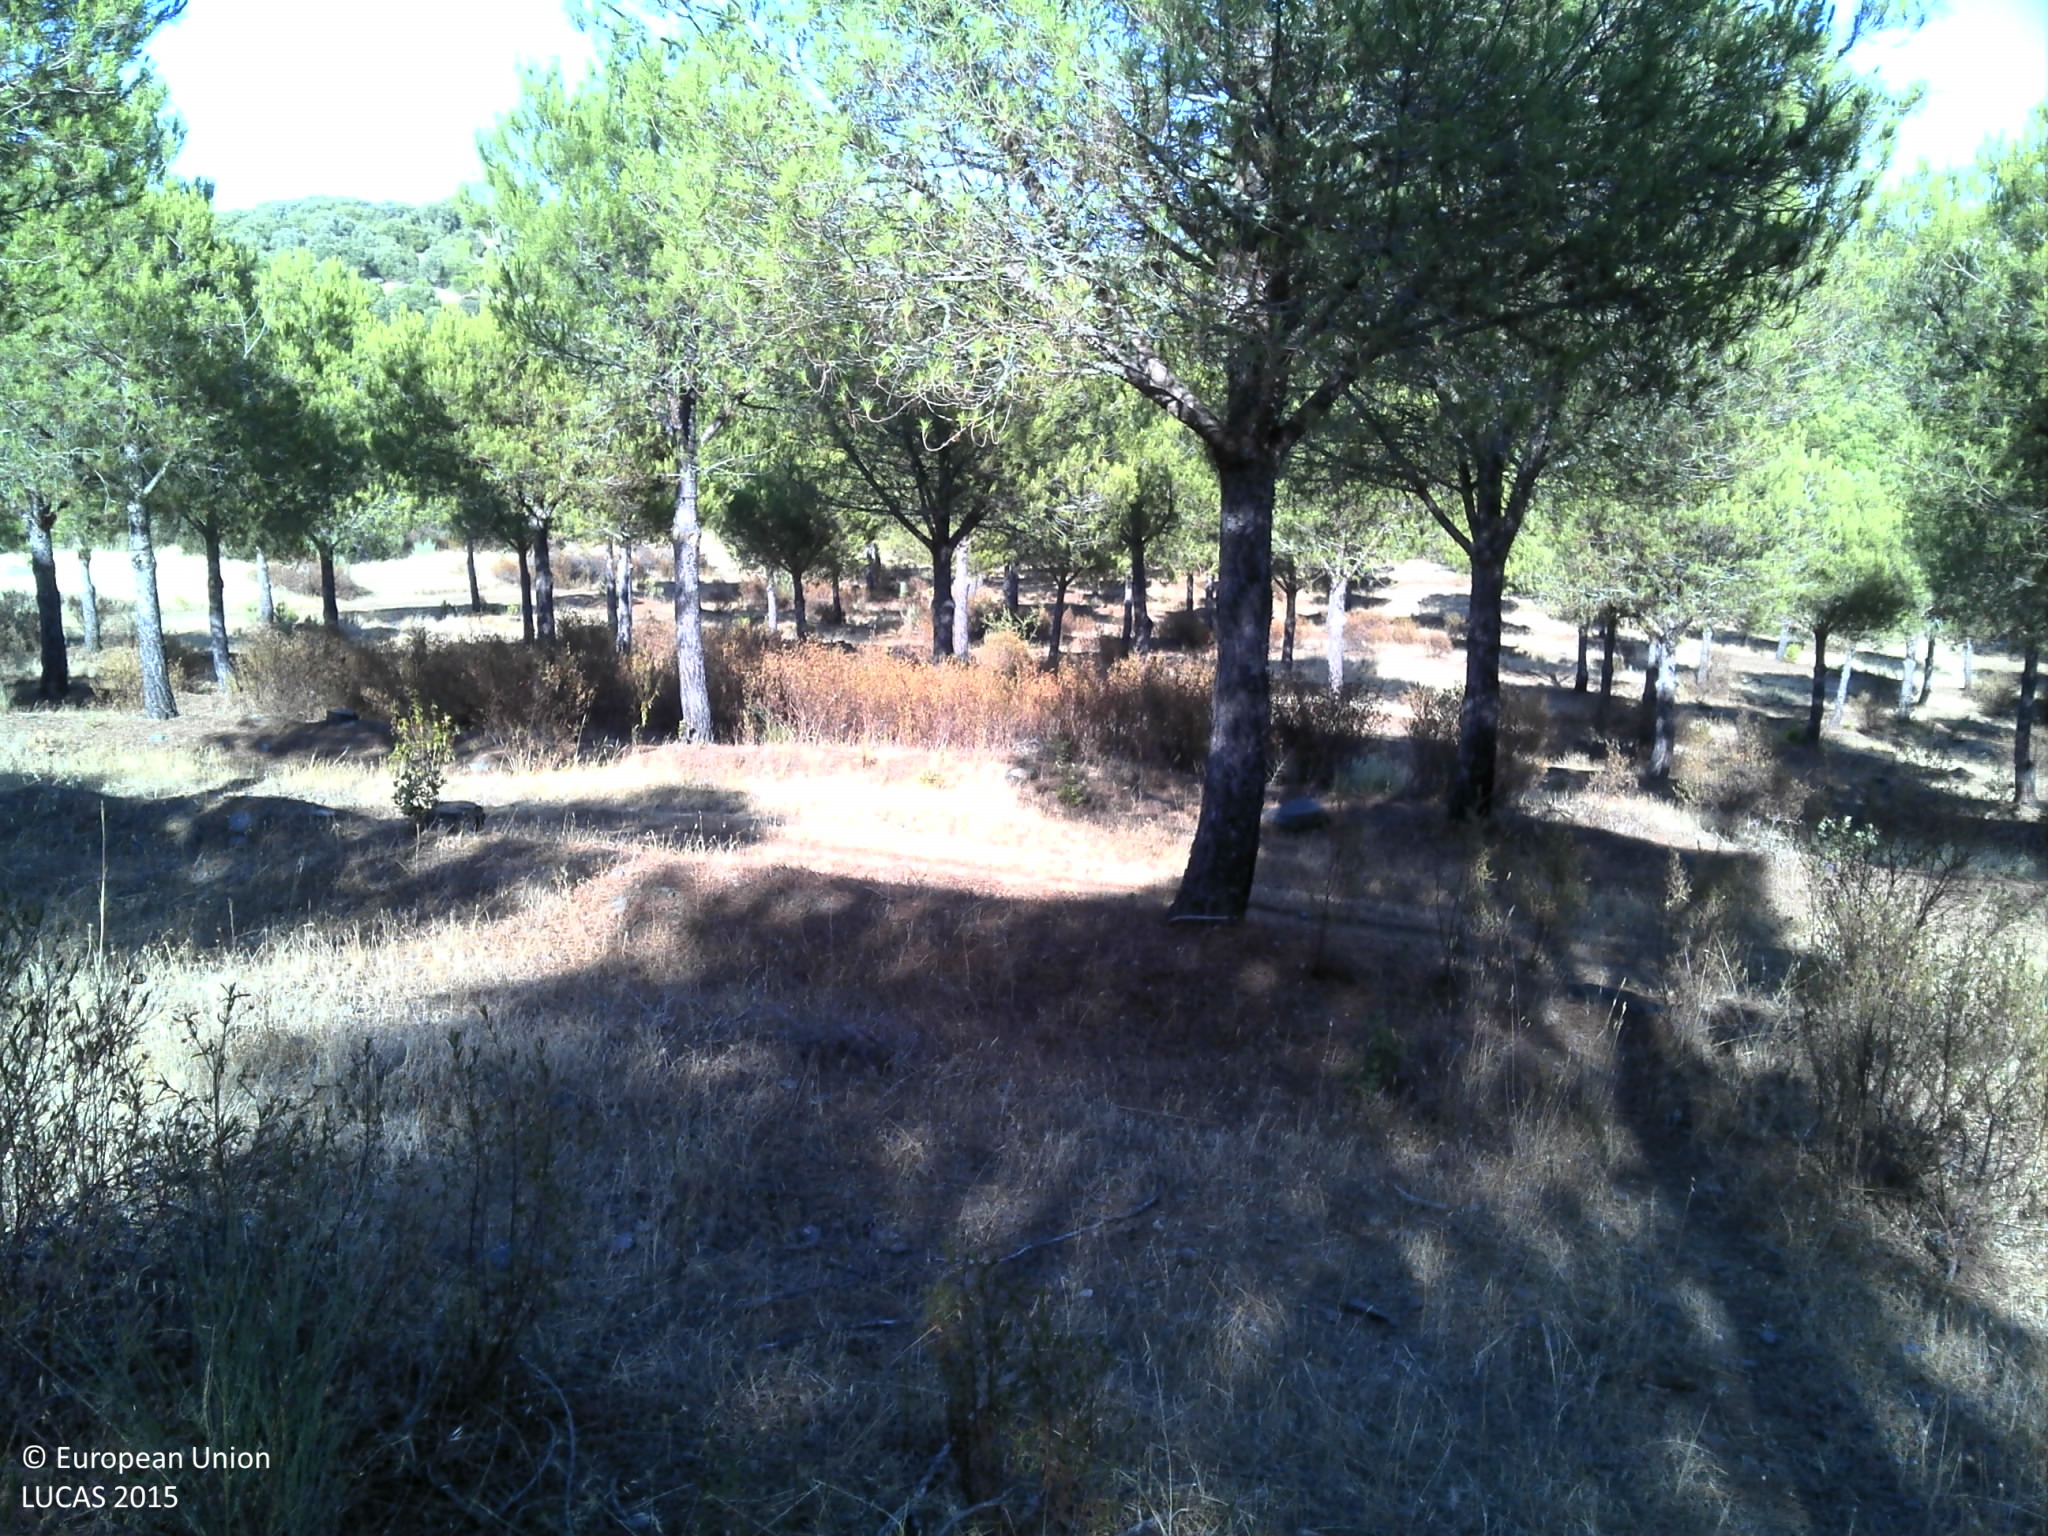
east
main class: Woodland
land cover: Pine dominated coniferous woodland
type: coniferous forest of the mediterranean region
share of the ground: > 75 %
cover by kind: coniferous forest trees 85 %, shrubs 5 %, herbaceous plants 5 %, unconsolidated bare surface 5 %
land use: Forestry
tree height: < 5 m
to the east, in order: Pine dominated coniferous woodland; Tracks; Pine dominated coniferous woodland; Rivers and streams; Pine dominated coniferous woodland; Grassland without tree/shrub cover; Rivers and streams; Grassland without tree/shrub cover
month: July
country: PT
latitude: 37.9247
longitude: -7.6893
